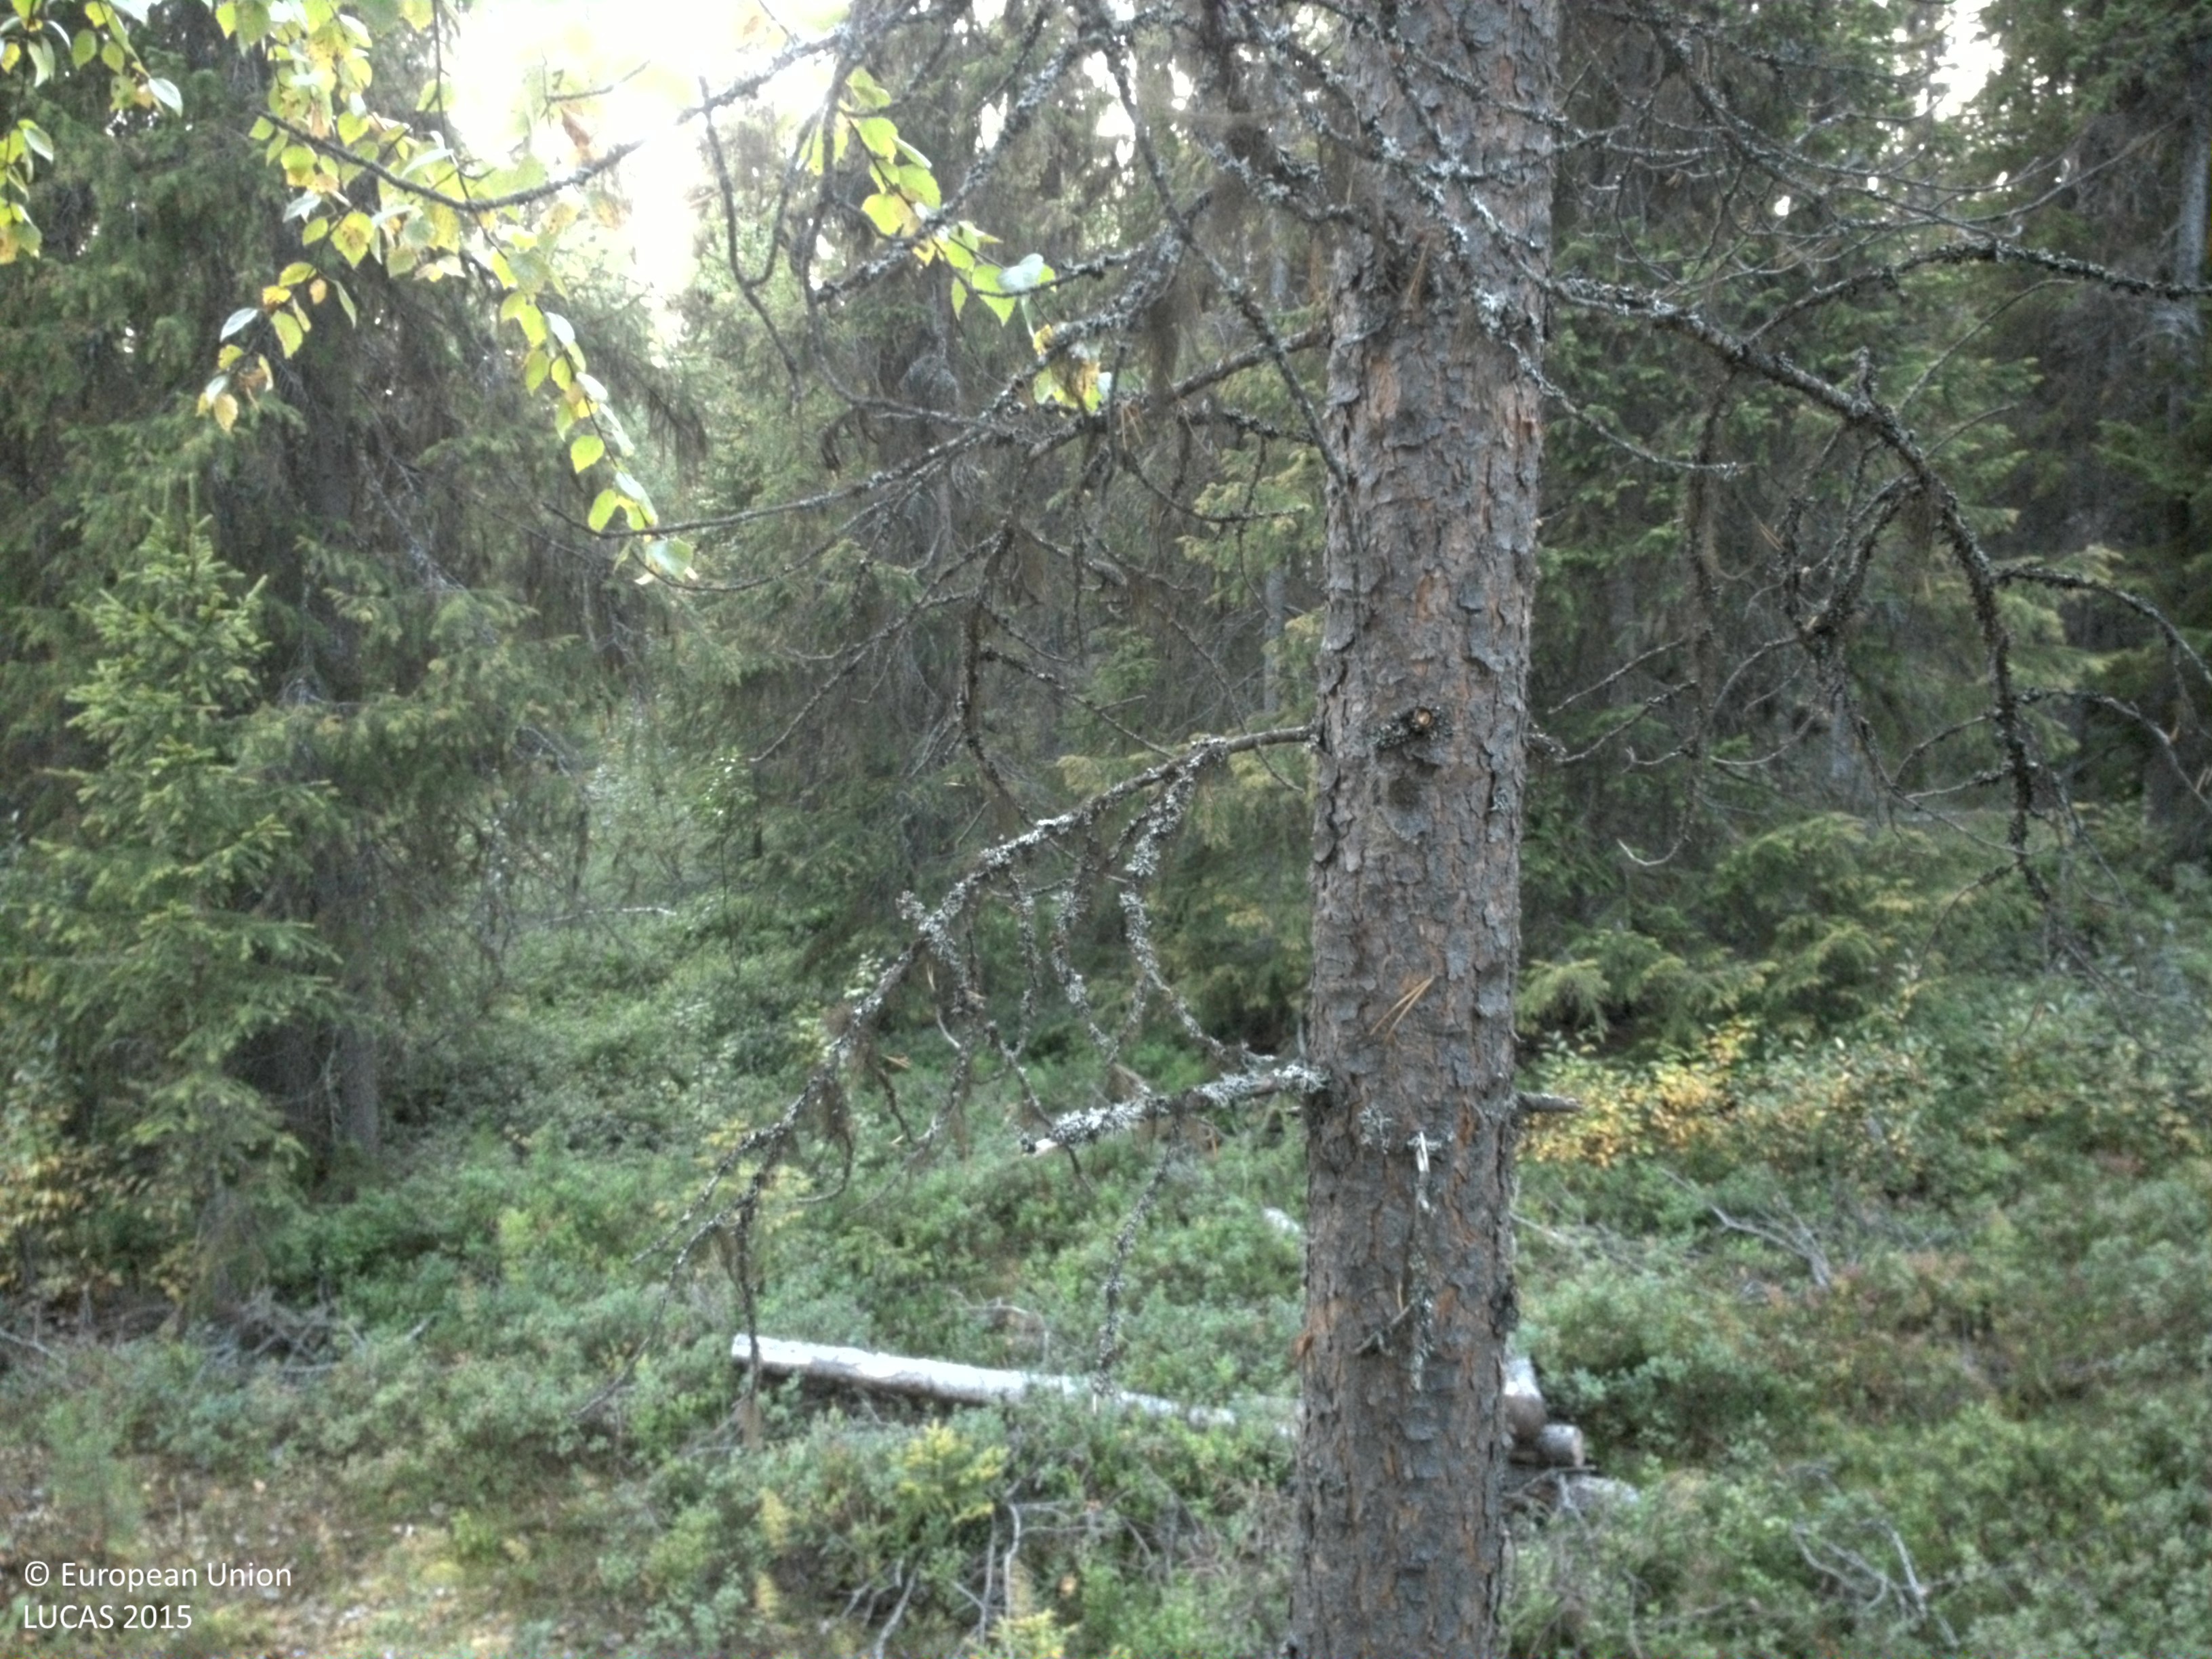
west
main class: Woodland
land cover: Pine dominated coniferous woodland
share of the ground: 25 - 50 %
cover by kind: shrubs 40 %, coniferous forest trees 30 %, herbaceous plants 20 %, broadleaved forest trees 5 %, lichens and mosses 5 %
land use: Forestry
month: September
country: SE
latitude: 65.2684
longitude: 16.7959
